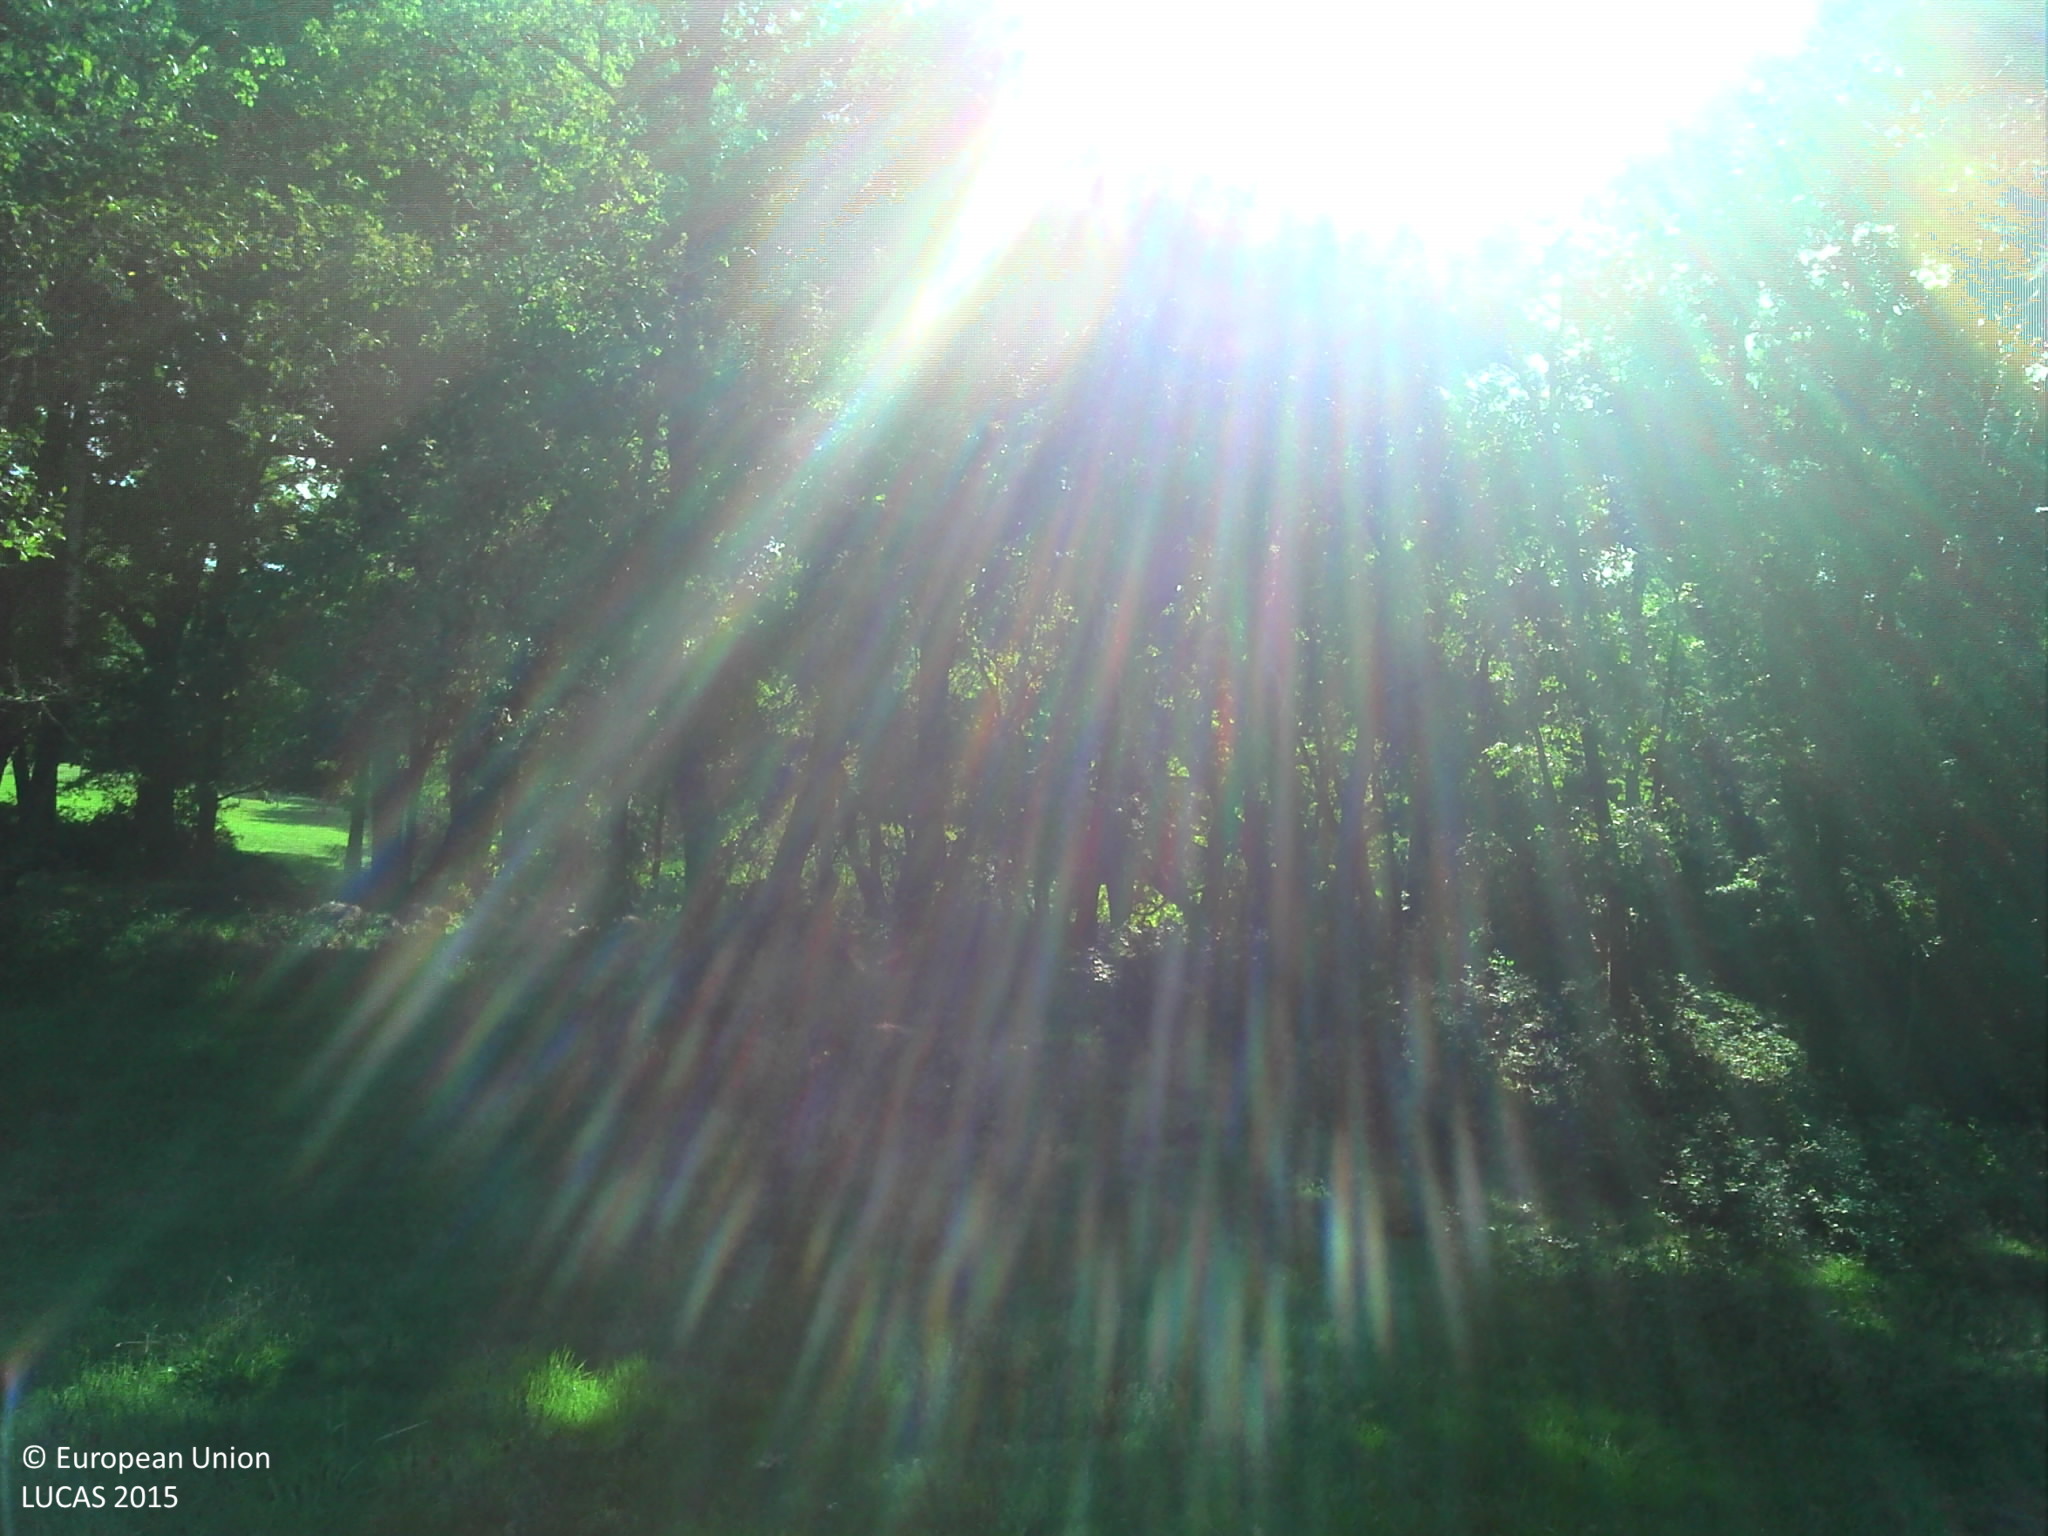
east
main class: Grassland
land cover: Spontaneously vegetated surfaces
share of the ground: > 75 %
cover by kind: herbaceous plants 60 %, unconsolidated bare surface 25 %, lichens and mosses 10 %, shrubs 5 %
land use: Semi-natural and natural areas not in use
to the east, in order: Fences; Spontaneously vegetated surfaces; Grassland without tree/shrub cover; Broadleaved woodland; Fences; Grassland without tree/shrub cover; Fences; Broadleaved woodland; Tracks; Fences; Ditches and canals; Single bushes/trees; Grassland without tree/shrub cover; Fences; Broadleaved woodland
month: August
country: FR
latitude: 45.4149
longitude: 0.6475
